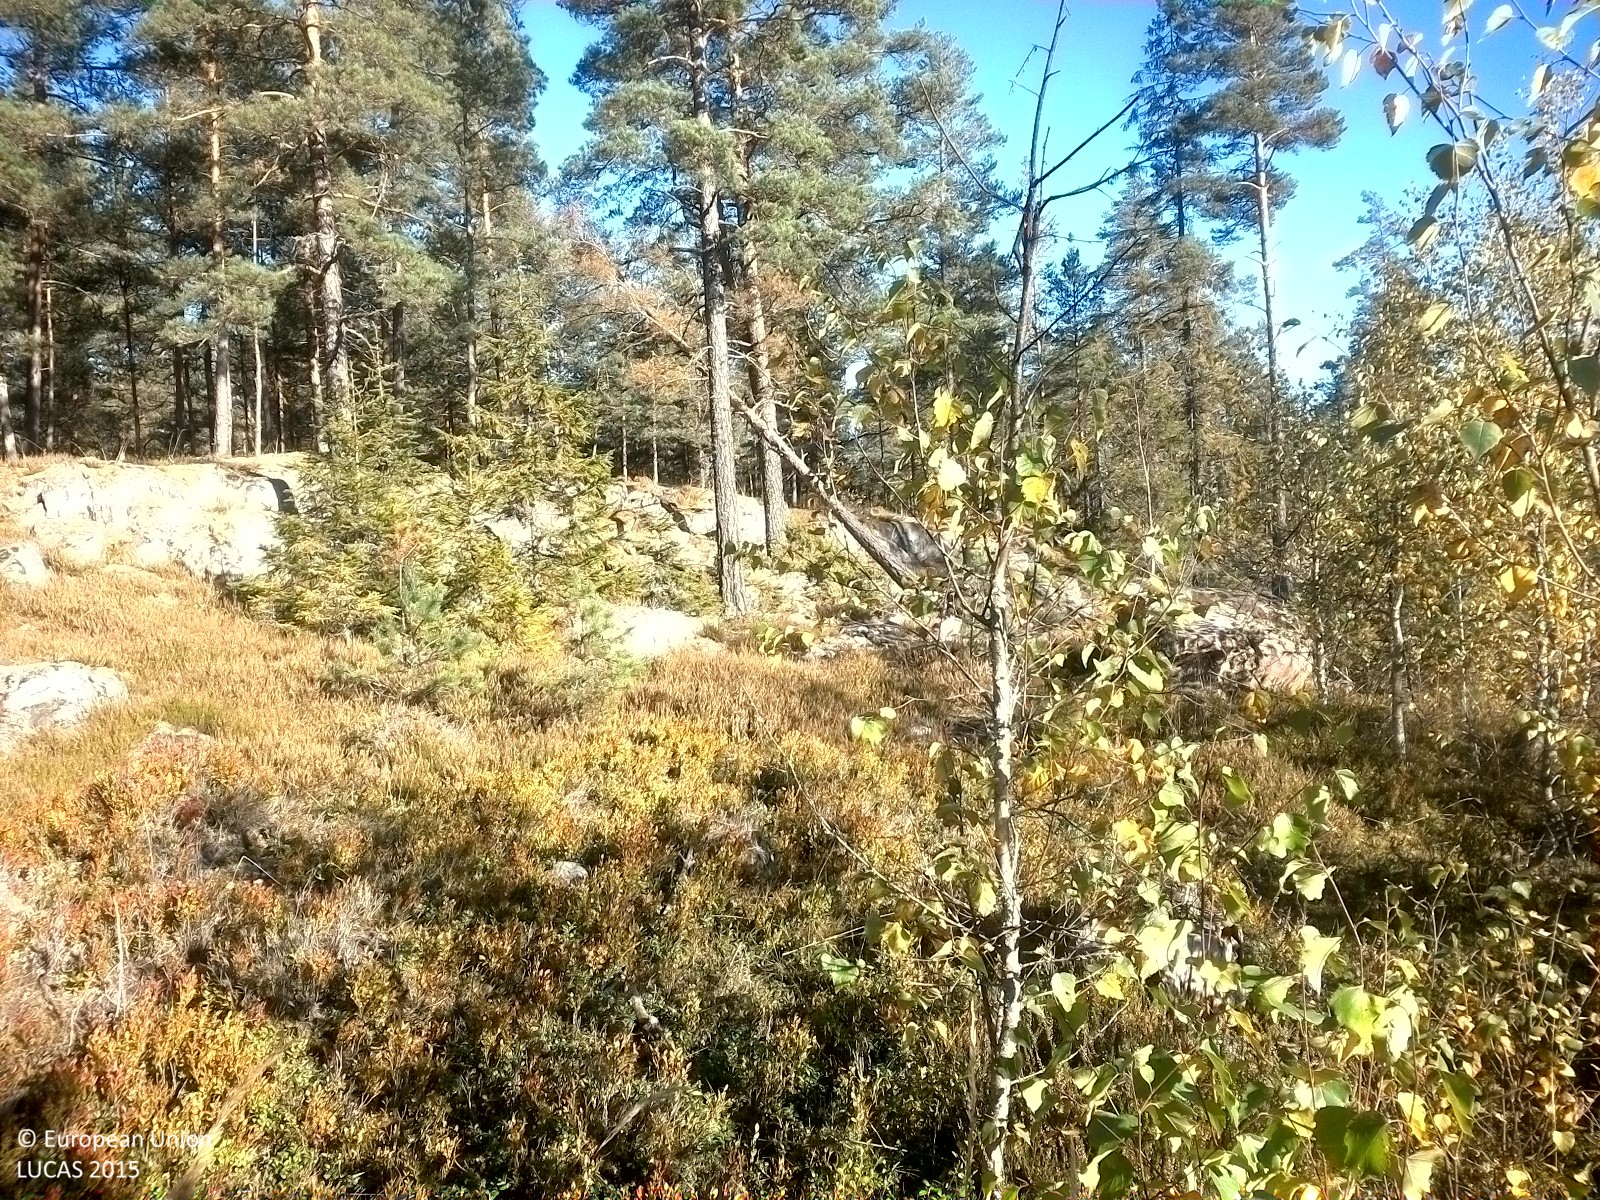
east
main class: Woodland
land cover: Spruce dominated mixed woodland
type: boreal forest
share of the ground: 25 - 50 %
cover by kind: herbaceous plants 35 %, coniferous forest trees 20 %, broadleaved forest trees 20 %, lichens and mosses 15 %, shrubs 10 %
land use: Forestry
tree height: < 5 m
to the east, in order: Spruce dominated mixed woodland; Pine dominated coniferous woodland; Spruce dominated coniferous woodland; Artificial constructions in urban areas; Spontaneously vegetated surfaces; Fences; Grassland with sparse tree/shrub cover; Fences; Broadleaved woodland
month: September
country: SE
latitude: 58.7495
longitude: 16.4759
